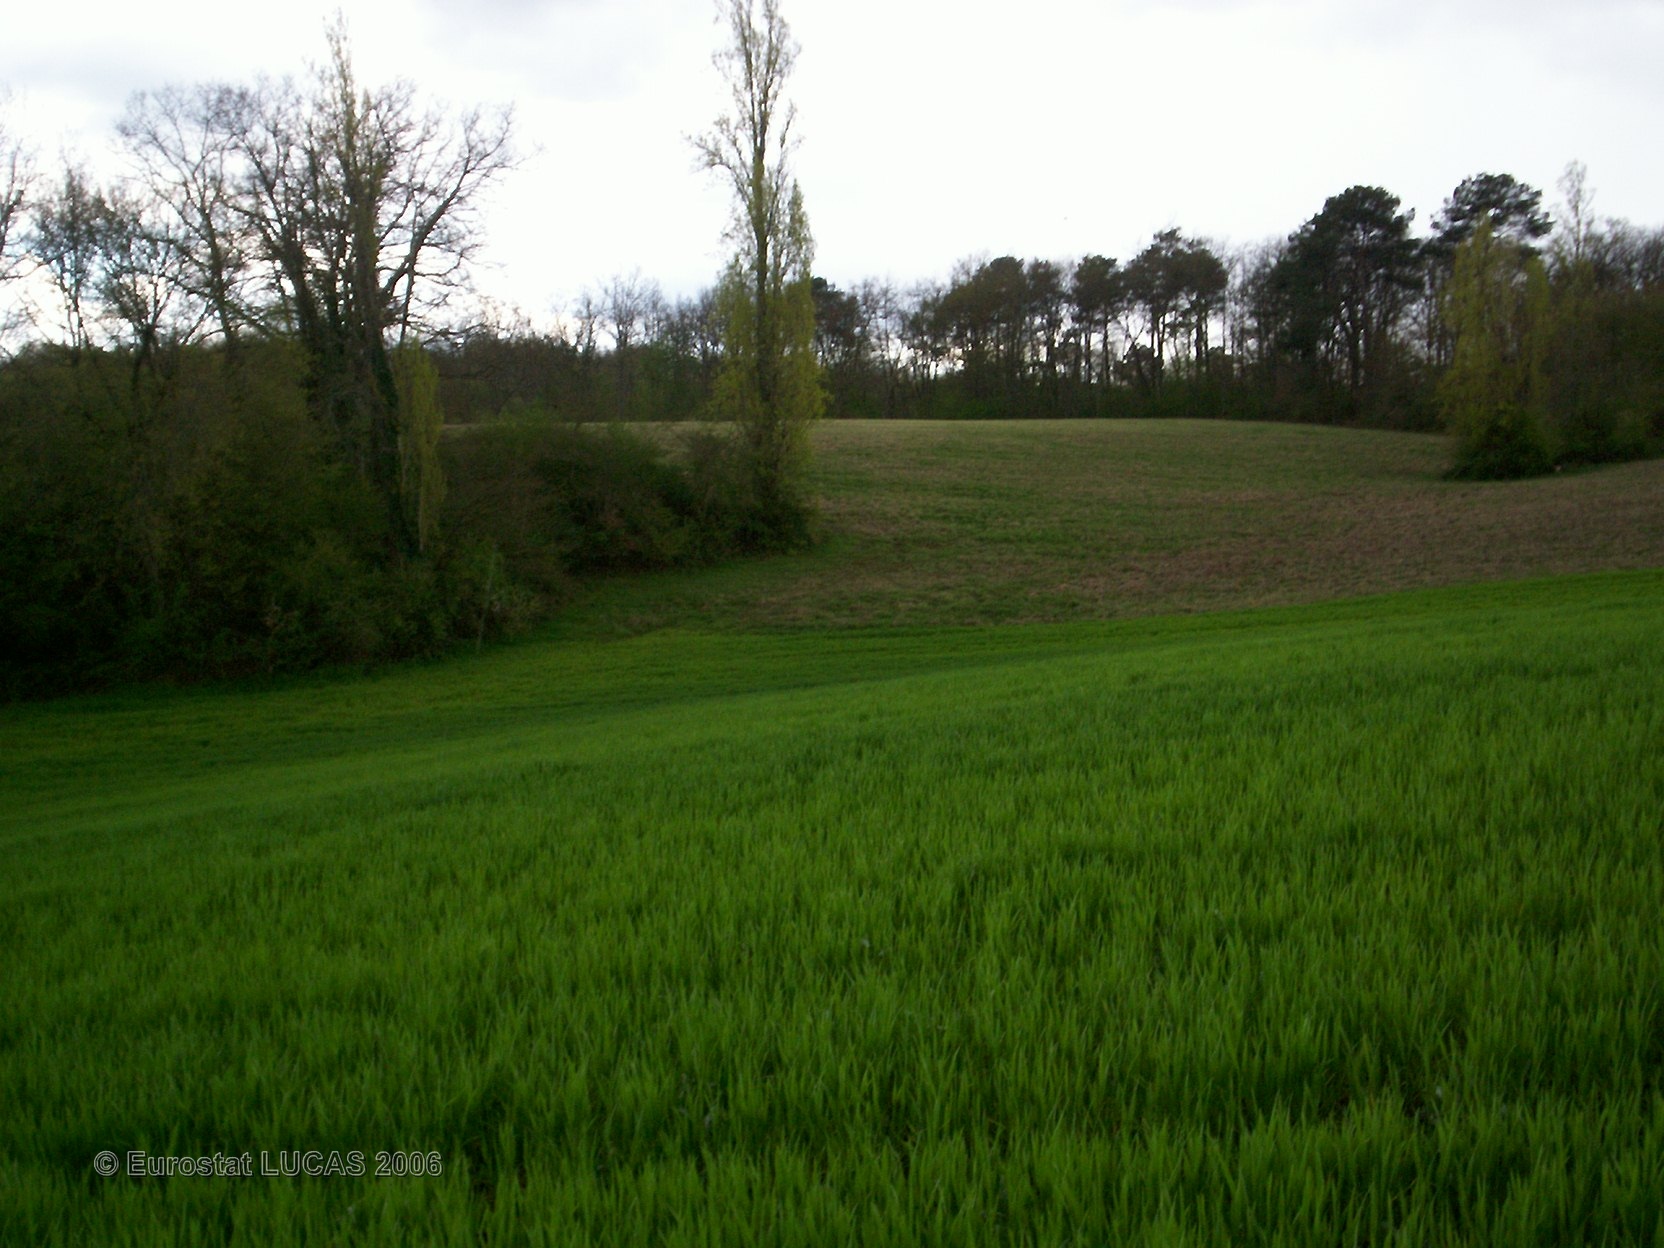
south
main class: Cropland
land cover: Common wheat
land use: Agriculture (excluding fallow land and kitchen gardens)
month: April
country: FR
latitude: 43.9546
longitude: 0.1609
